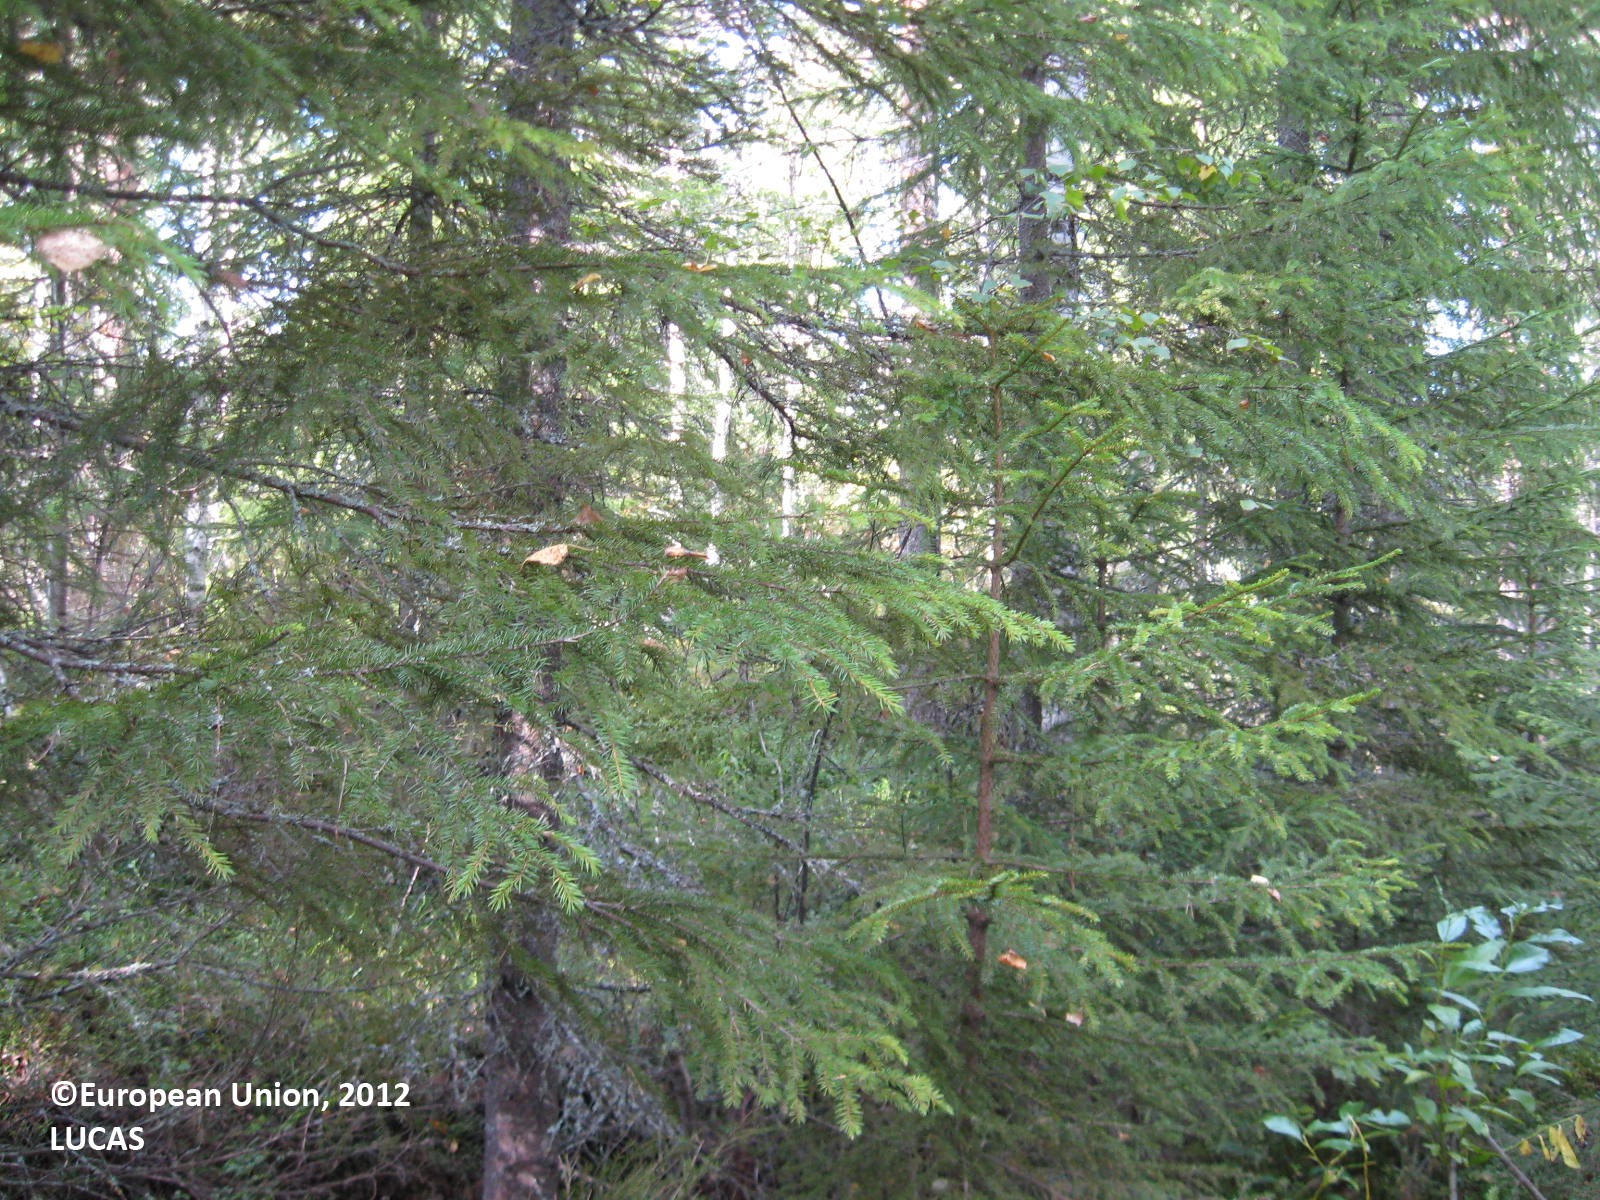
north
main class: Woodland
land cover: Other mixed woodland
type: boreal forest
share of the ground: > 75 %
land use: Forestry
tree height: > 5 m
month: August
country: FI
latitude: 63.6898
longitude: 29.6647
